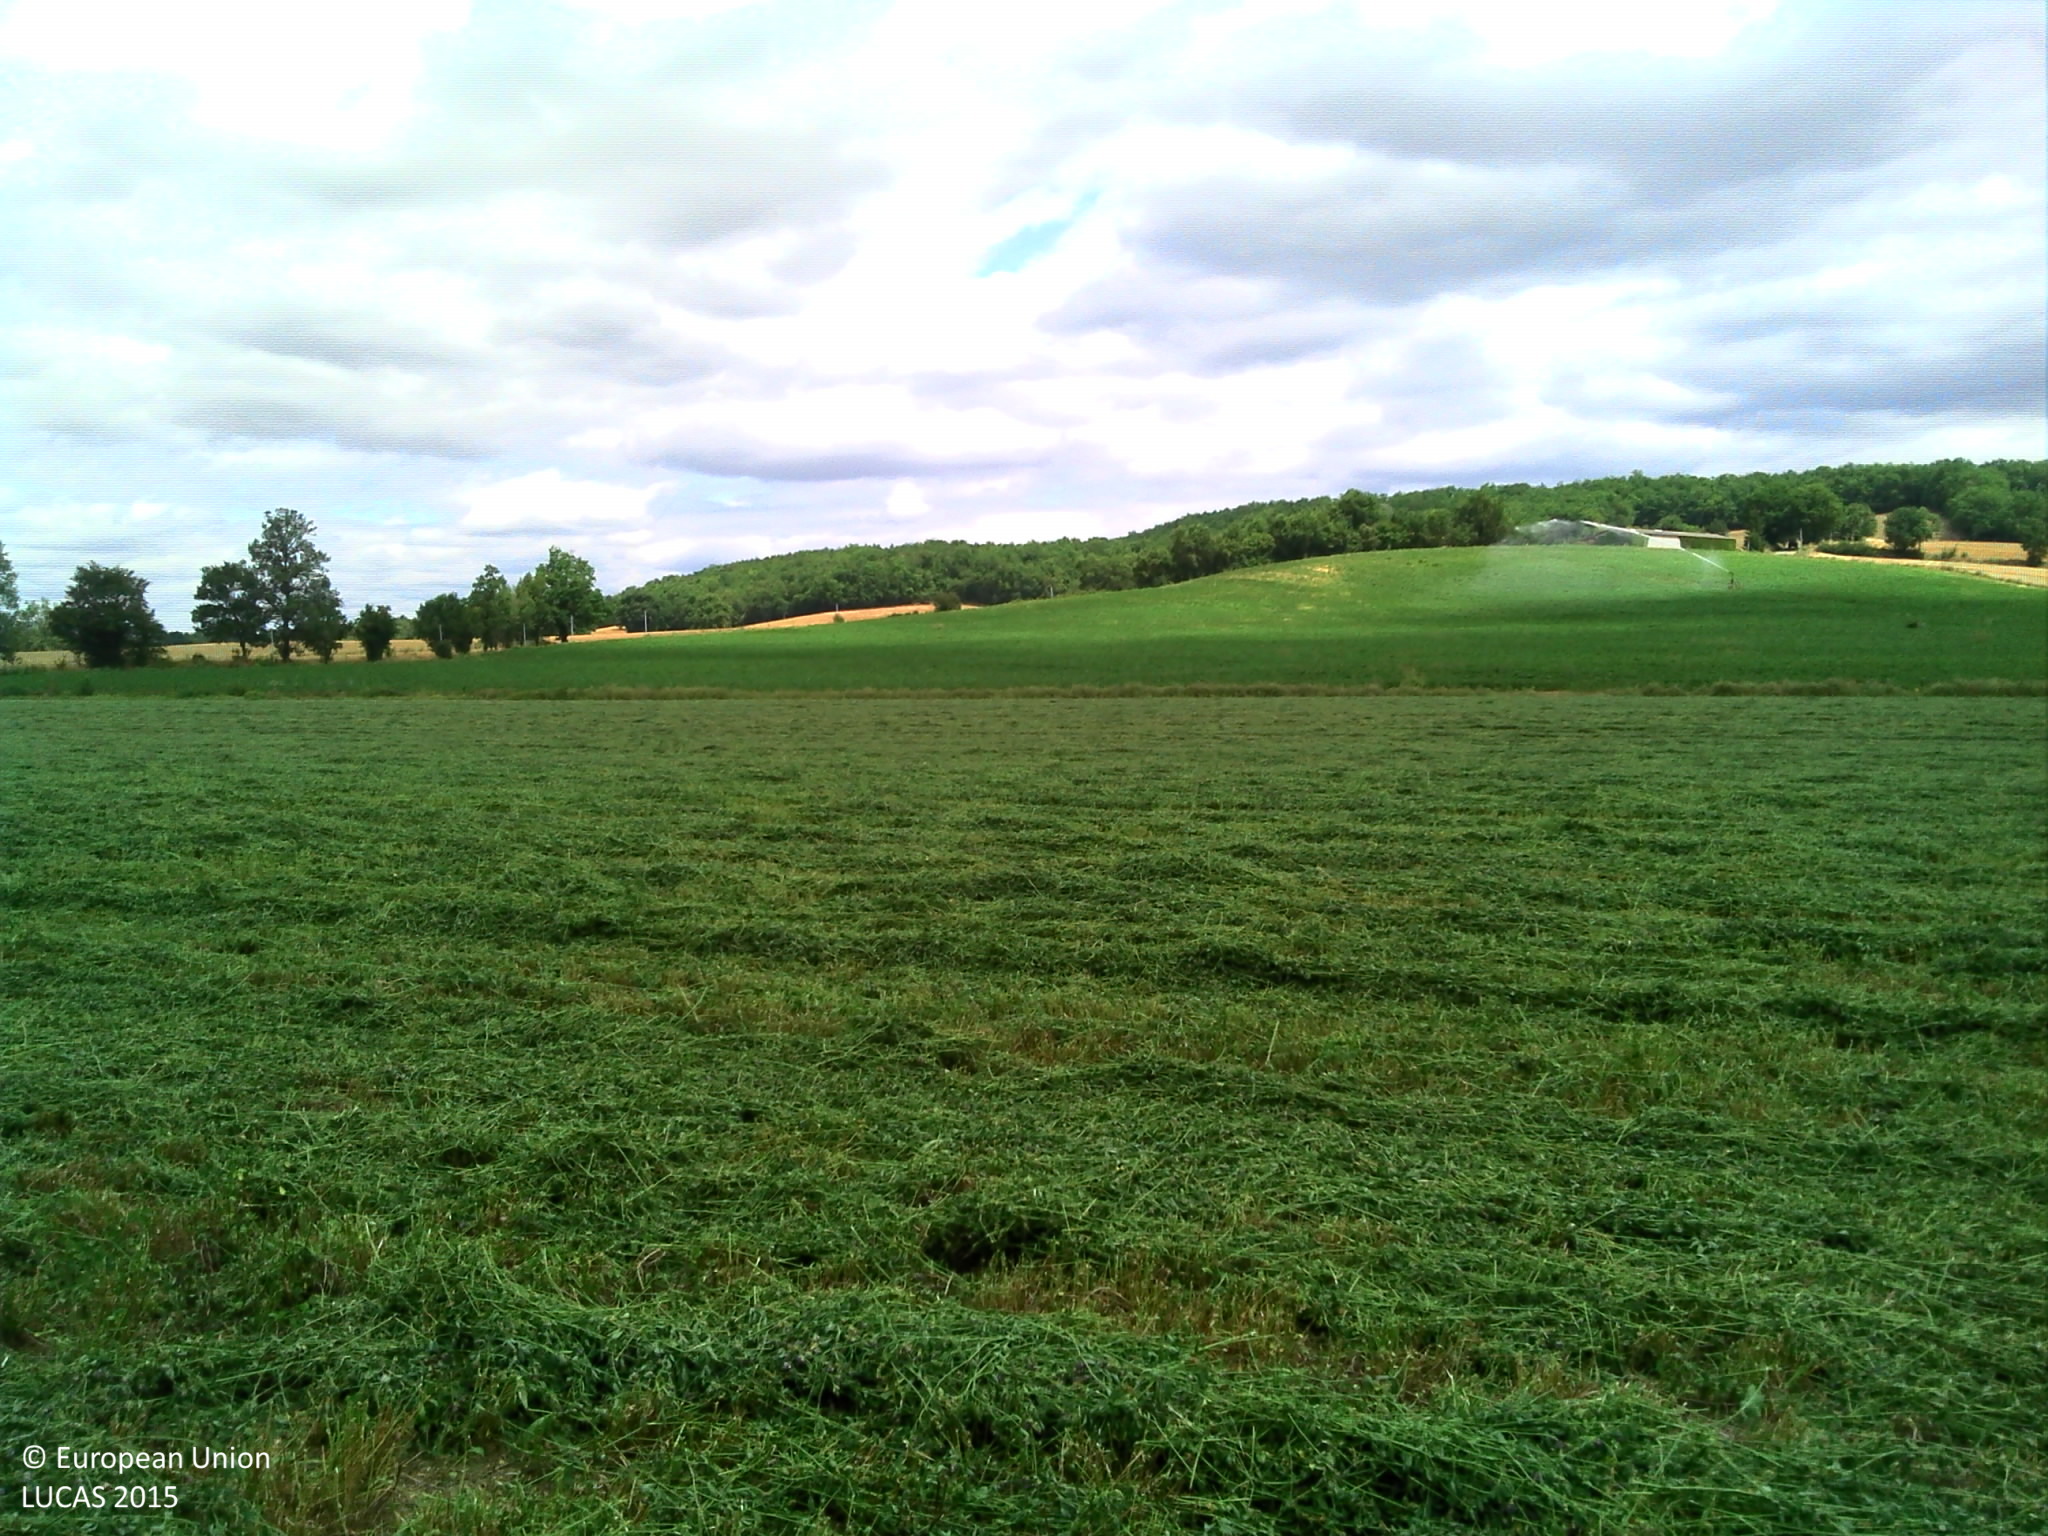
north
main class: Cropland
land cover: Lucerne
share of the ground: > 75 %
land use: Agriculture (excluding fallow land and kitchen gardens)
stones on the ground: < 10 %
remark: Harvested field
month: July
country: FR
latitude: 44.6644
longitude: 0.7734
